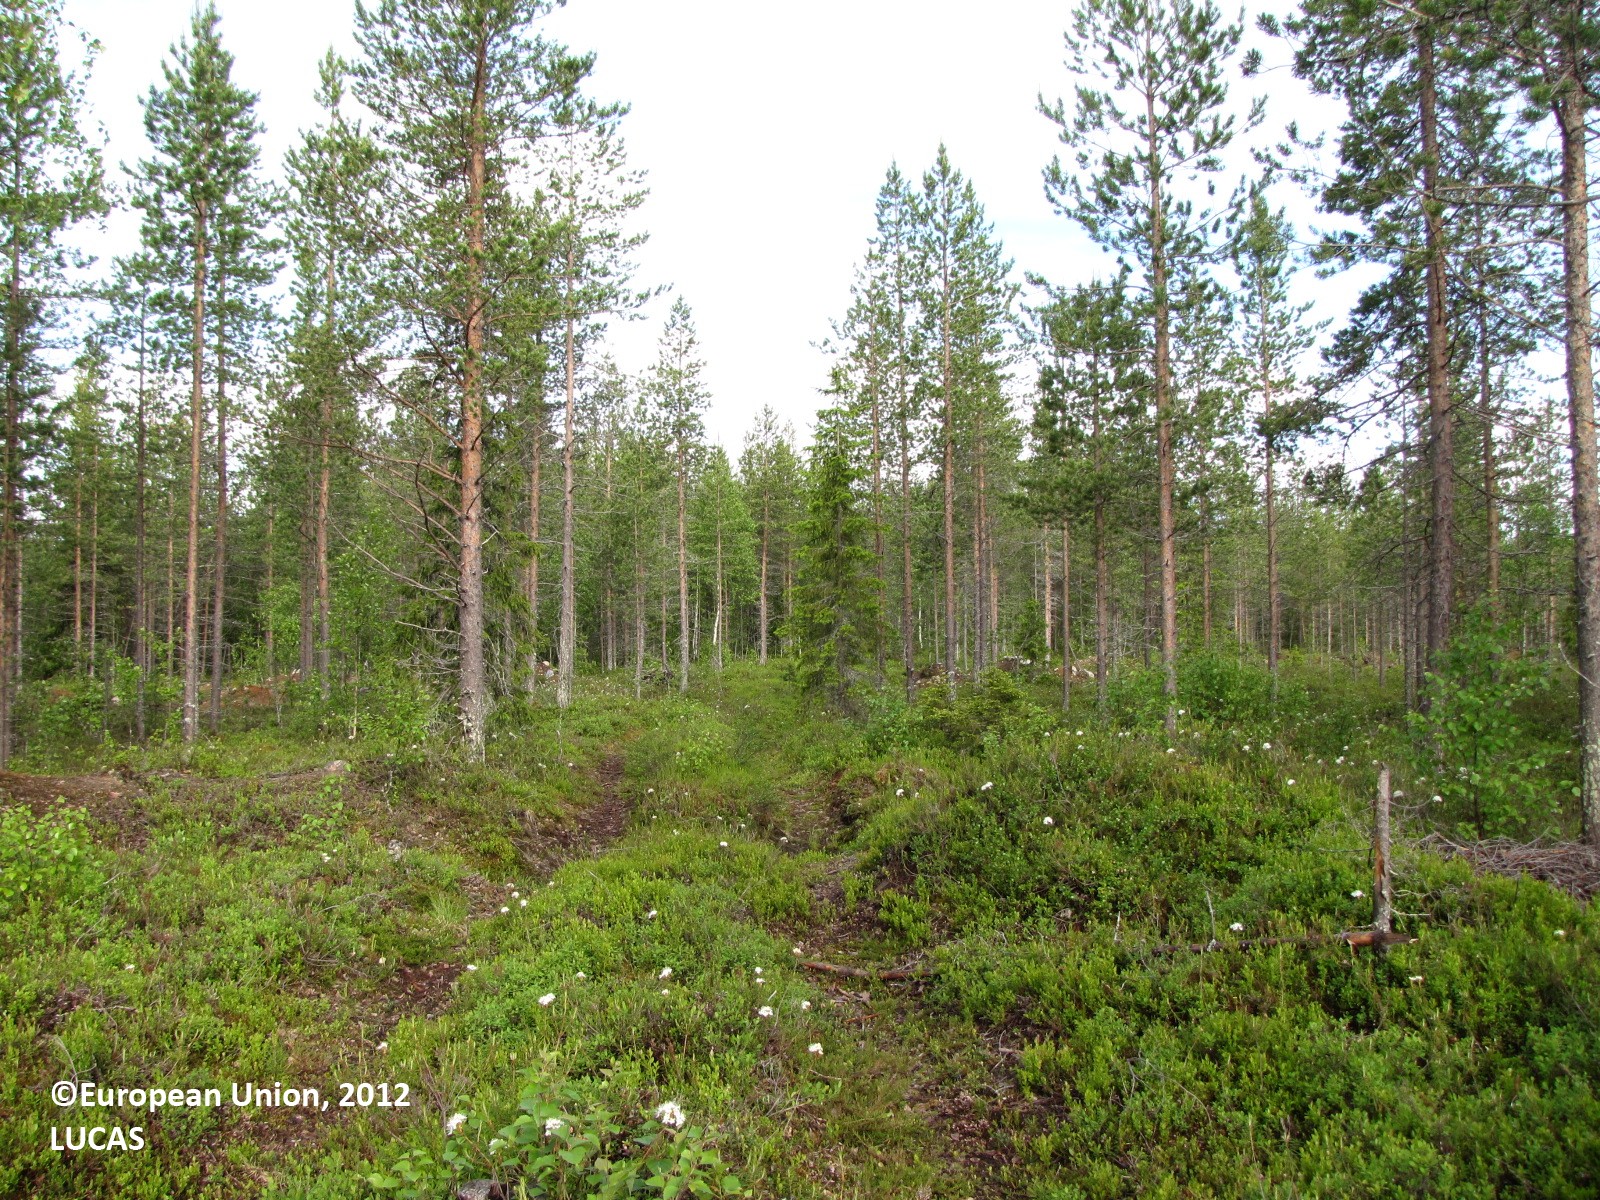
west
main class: Woodland
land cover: Pine dominated coniferous woodland
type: boreal forest
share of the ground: 50 - 75 %
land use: Forestry
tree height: > 5 m
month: June
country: FI
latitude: 66.4221
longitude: 24.4962
